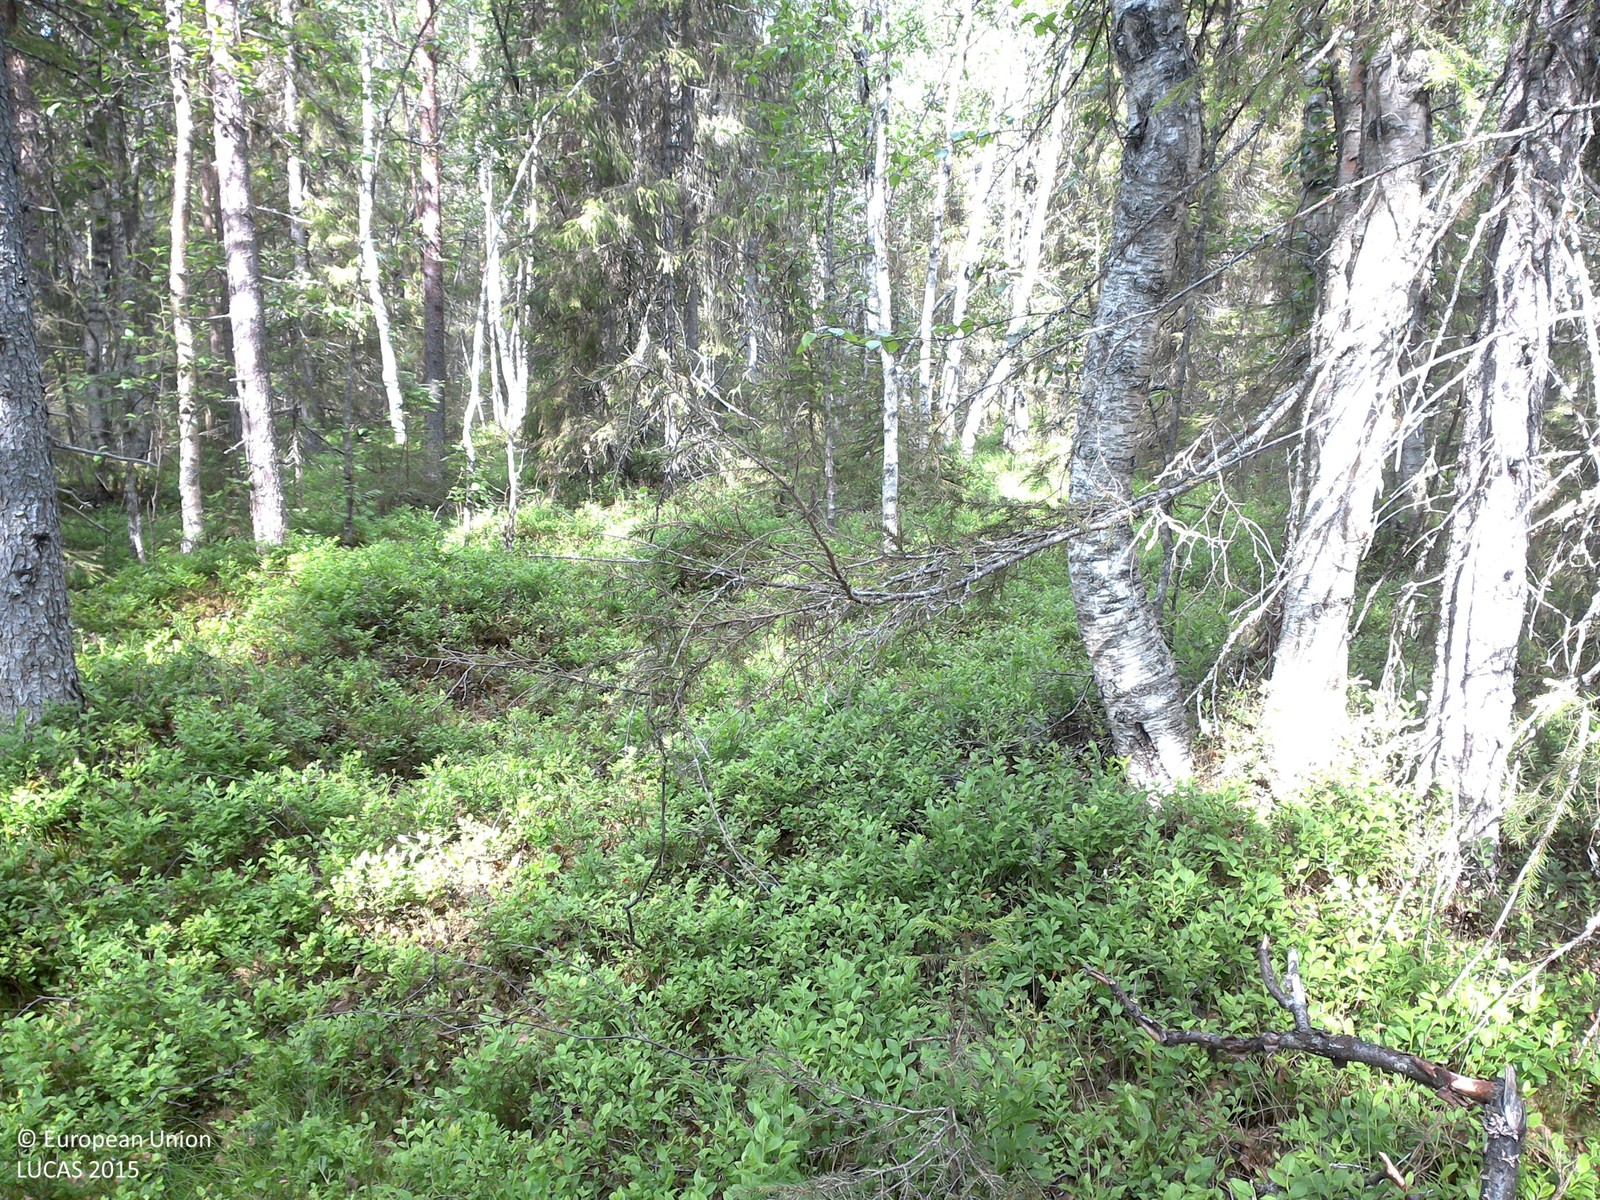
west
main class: Woodland
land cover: Spruce dominated mixed woodland
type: boreal forest
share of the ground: 25 - 50 %
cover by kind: shrubs 55 %, coniferous forest trees 30 %, broadleaved forest trees 10 %, lichens and mosses 5 %
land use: Forestry
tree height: > 5 m
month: July
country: SE
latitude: 67.1392
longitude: 22.6744
